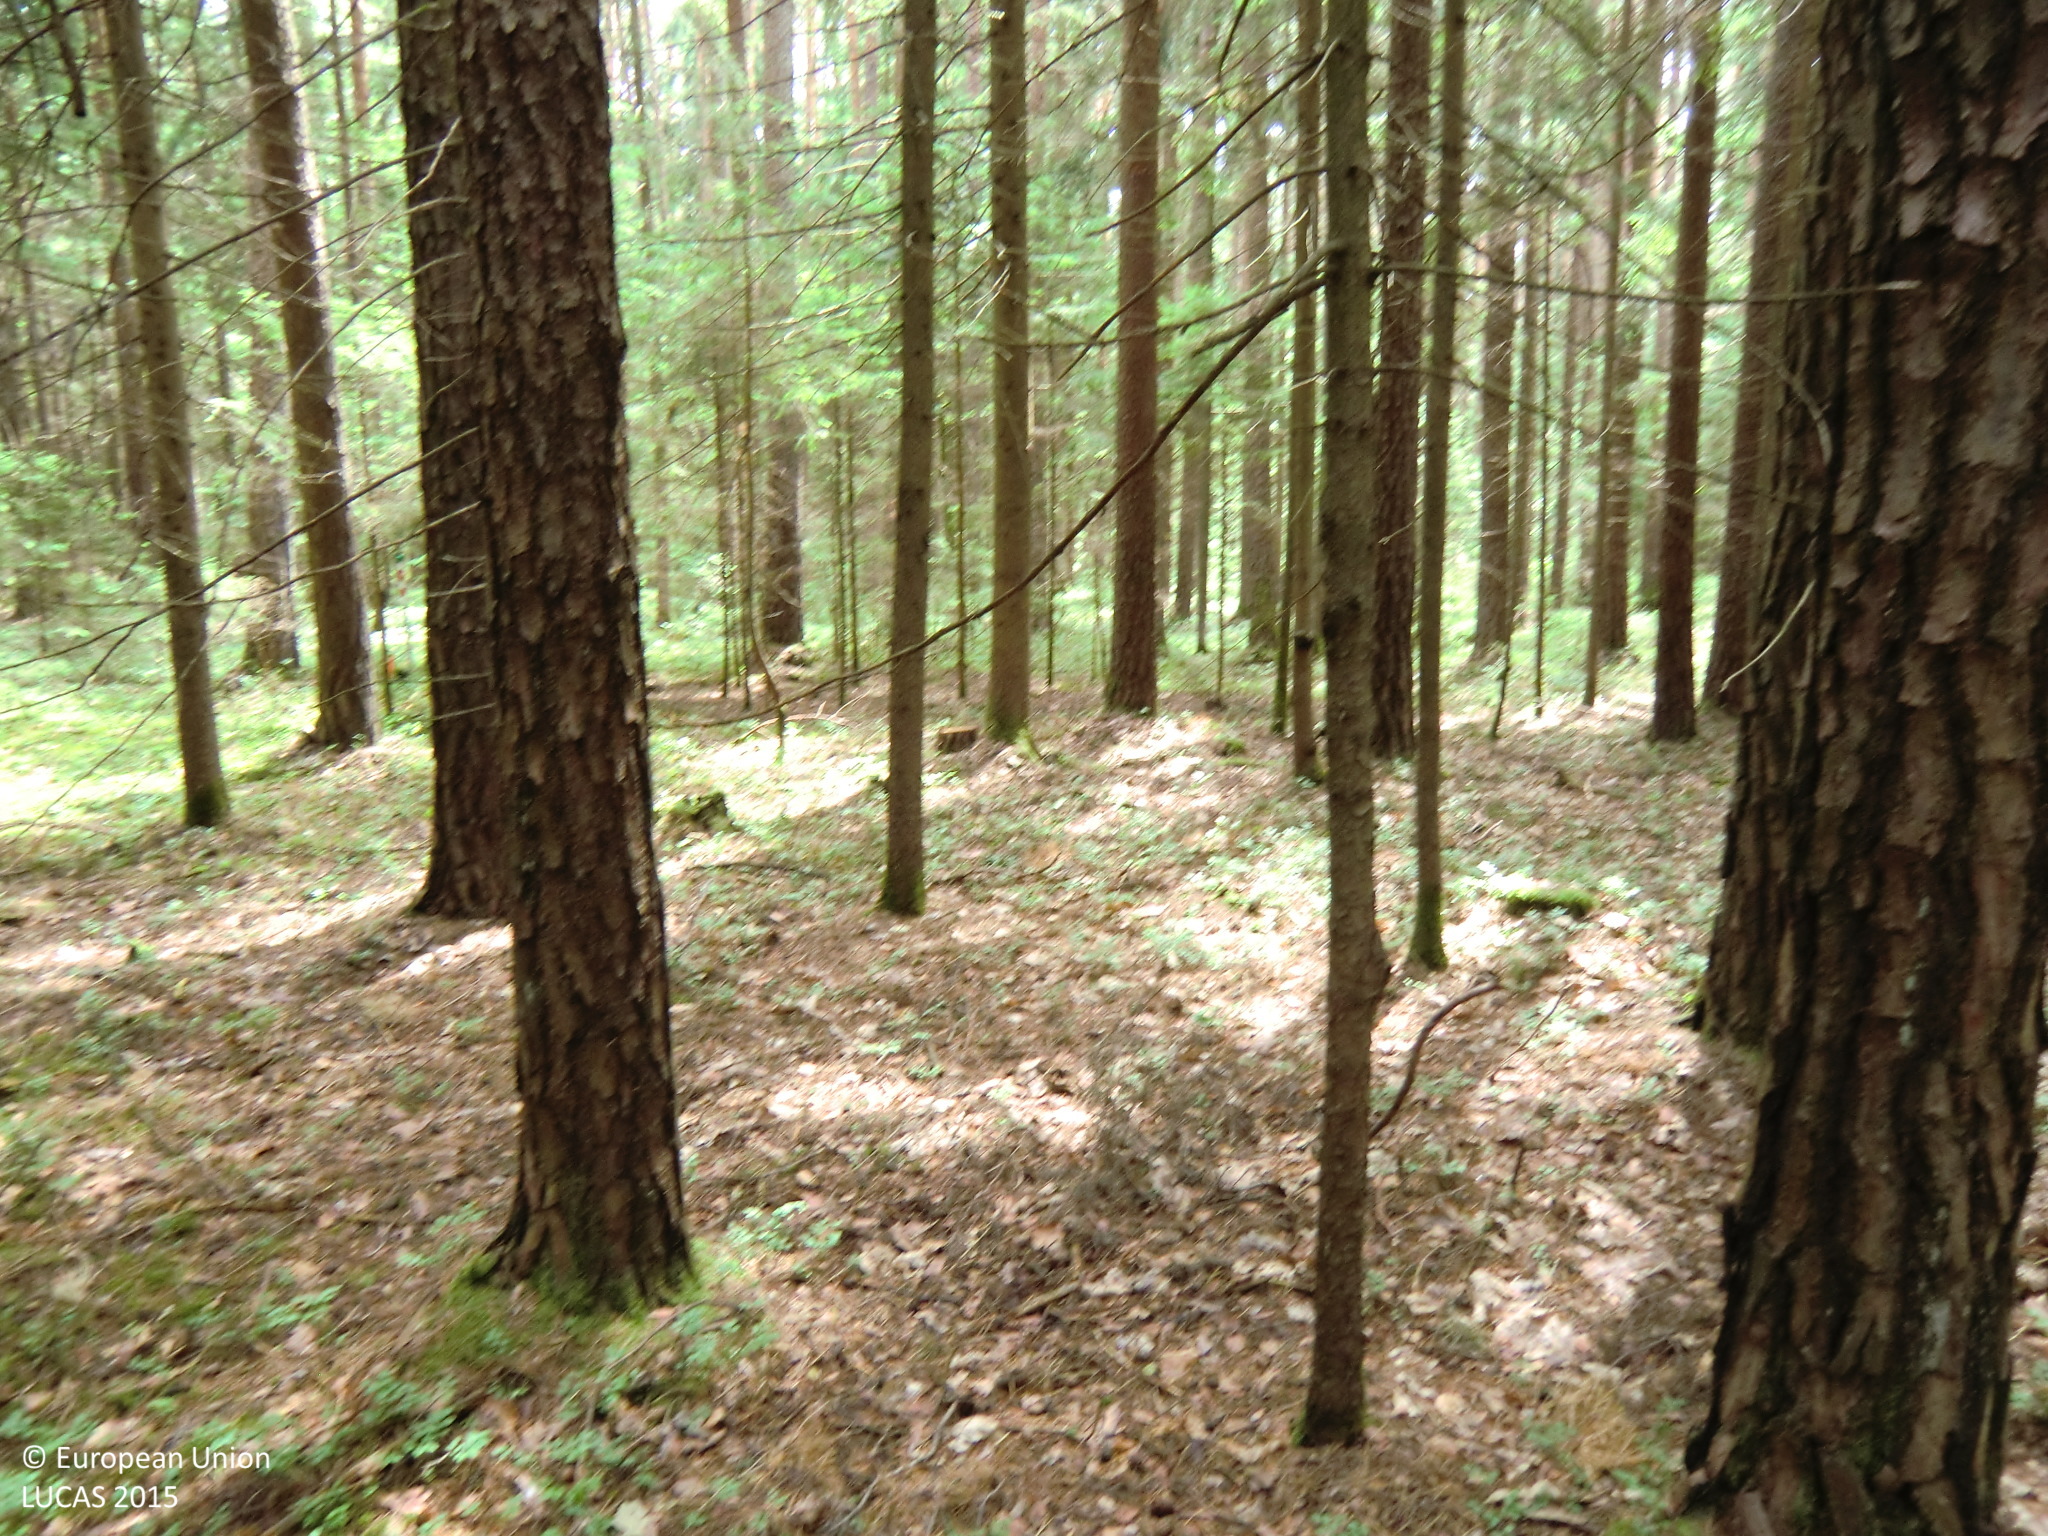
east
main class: Woodland
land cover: Pine dominated coniferous woodland
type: hemiboreal forest and nemoral coniferous forest and mixed broadleaved-coniferous forest
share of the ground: 50 - 75 %
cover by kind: coniferous forest trees 60 %, shrubs 20 %, unconsolidated bare surface 20 %
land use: Forestry
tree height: > 5 m
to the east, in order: Pine dominated coniferous woodland; Tracks; Pine dominated coniferous woodland
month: June
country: AT
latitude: 47.2623
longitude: 16.0679
